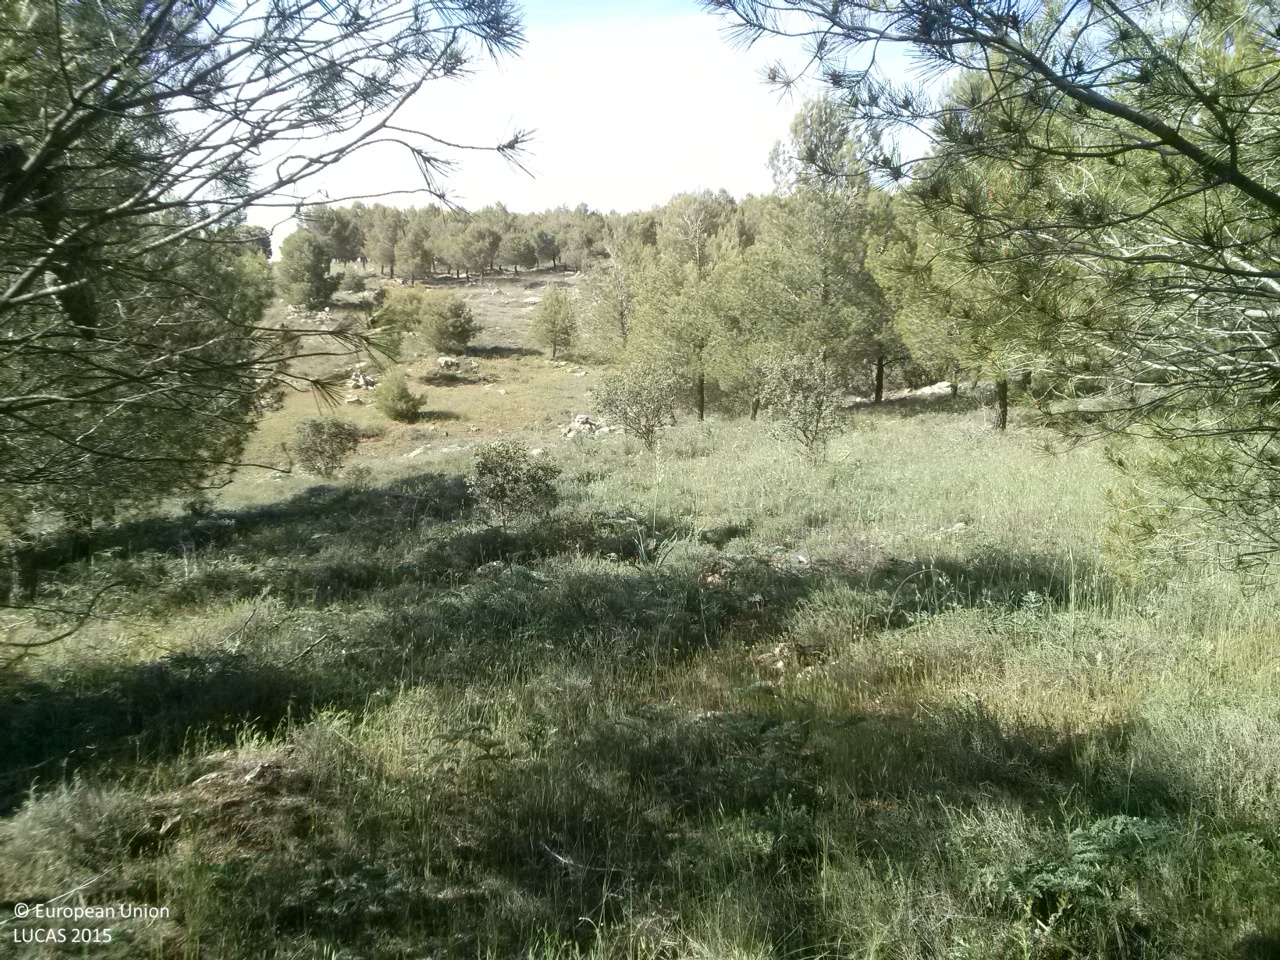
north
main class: Woodland
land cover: Pine dominated coniferous woodland
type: coniferous forest of the mediterranean region
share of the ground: 50 - 75 %
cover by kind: coniferous forest trees 65 %, herbaceous plants 25 %, consolidated bare surface 10 %
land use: Forestry
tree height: < 5 m
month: May
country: ES
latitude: 39.8320
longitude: -2.7670
